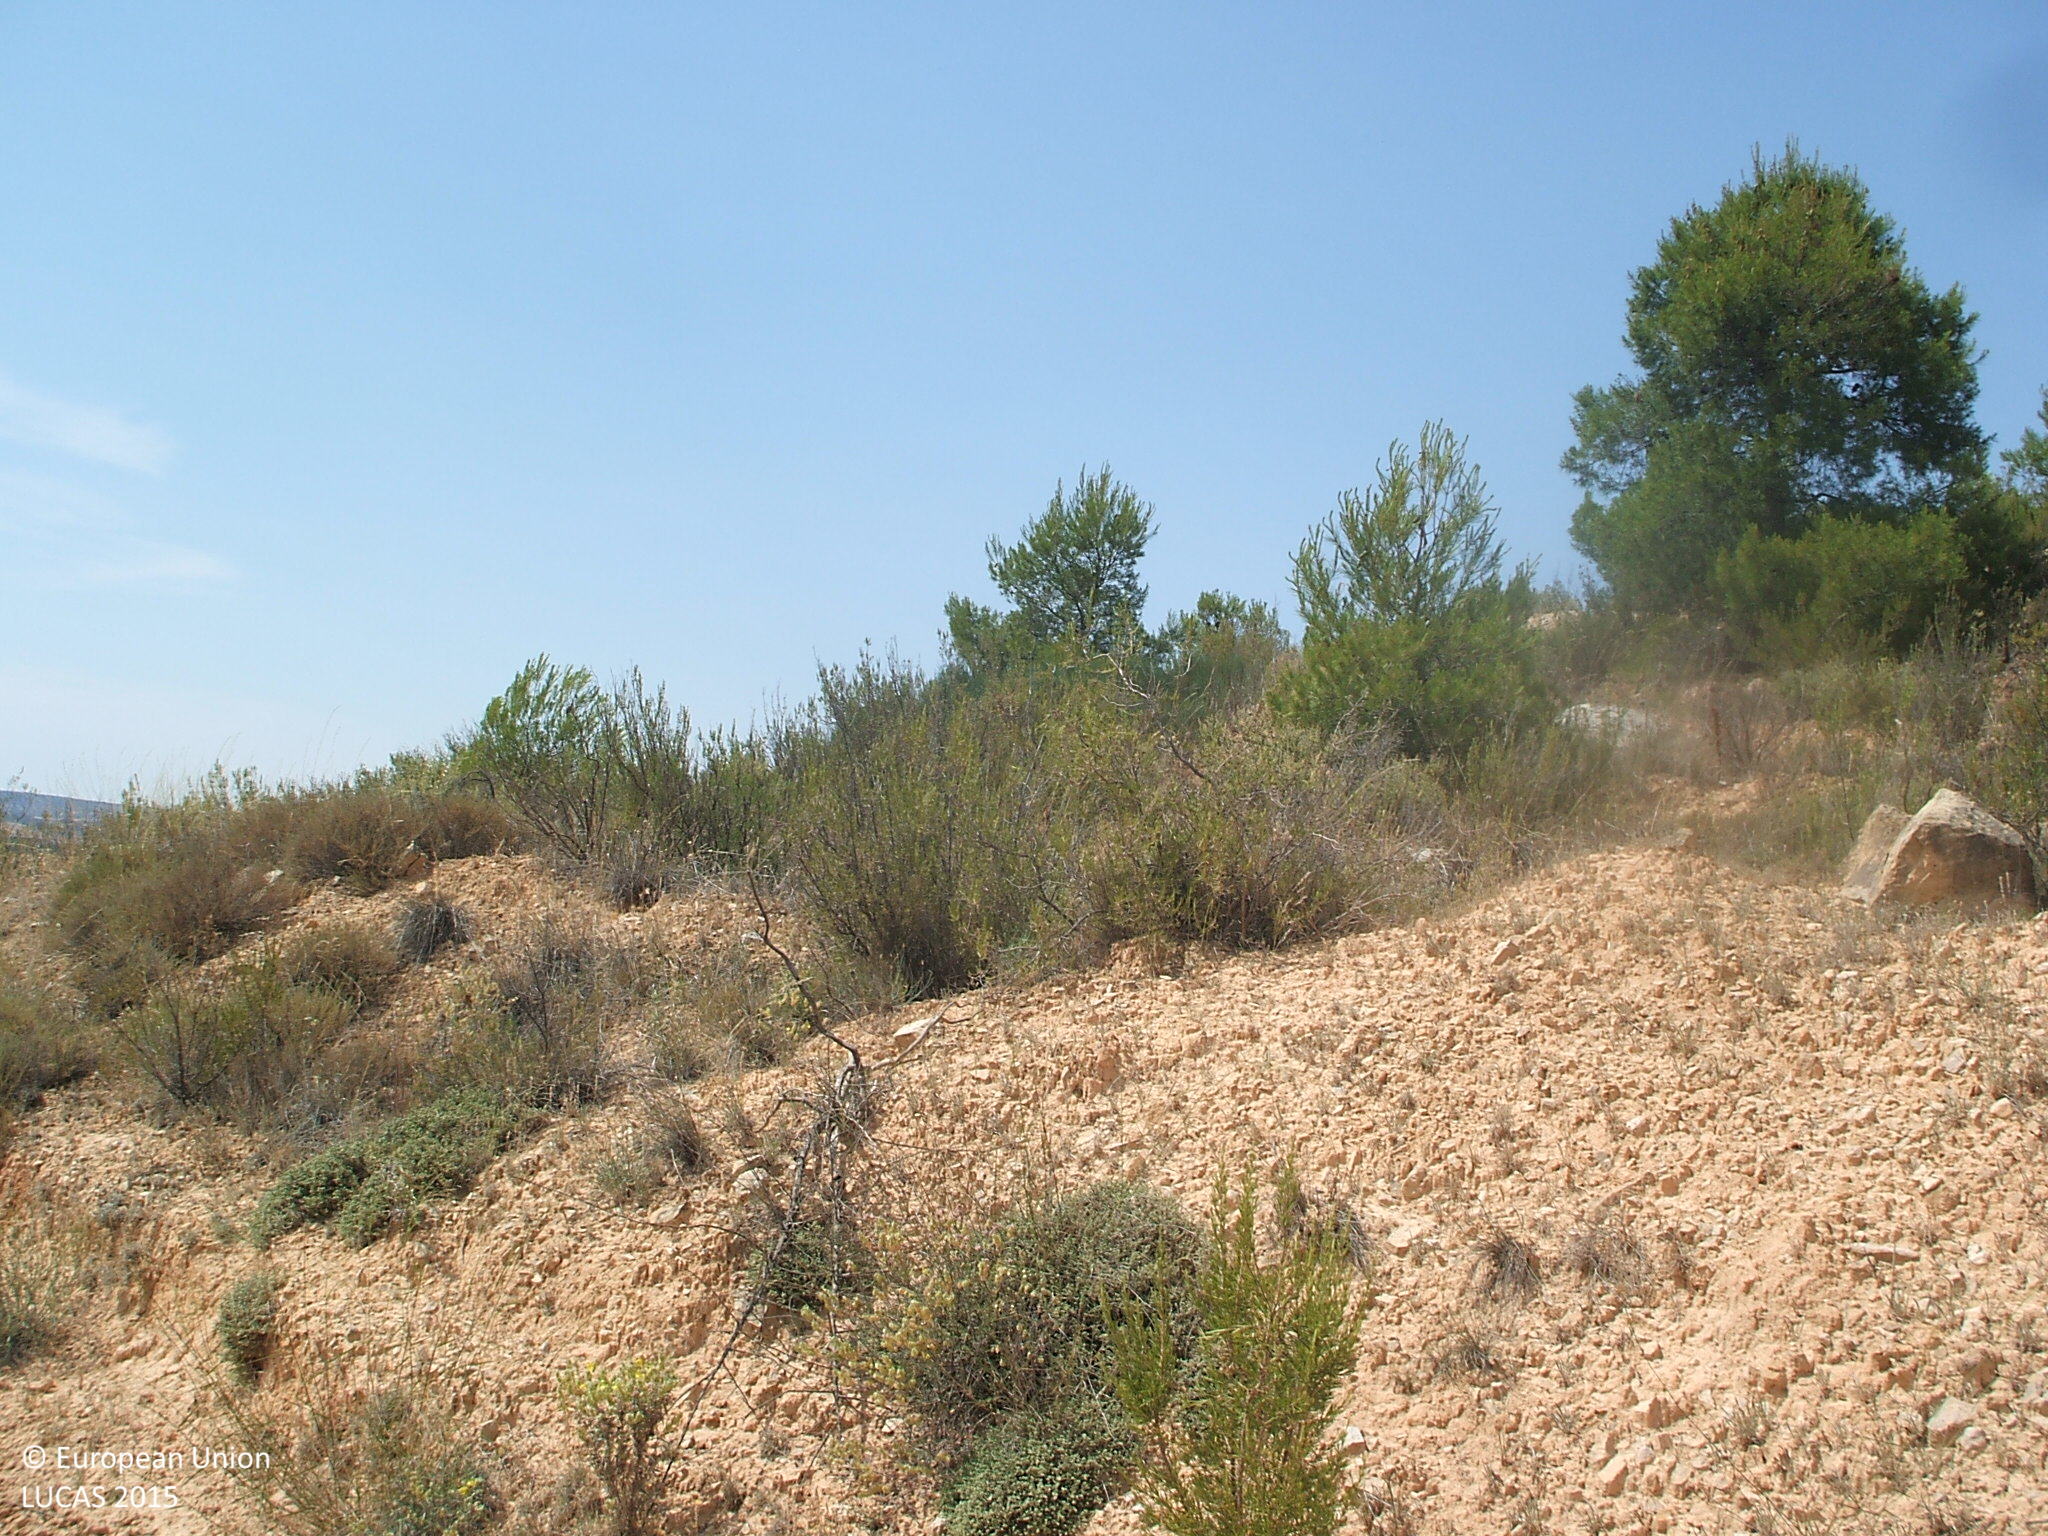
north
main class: Cropland
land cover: Nuts trees
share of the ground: < 10 %
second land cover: Other bare soil
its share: > 75 %
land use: Agriculture (excluding fallow land and kitchen gardens)
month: June
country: ES
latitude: 41.1003
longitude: -0.0247
